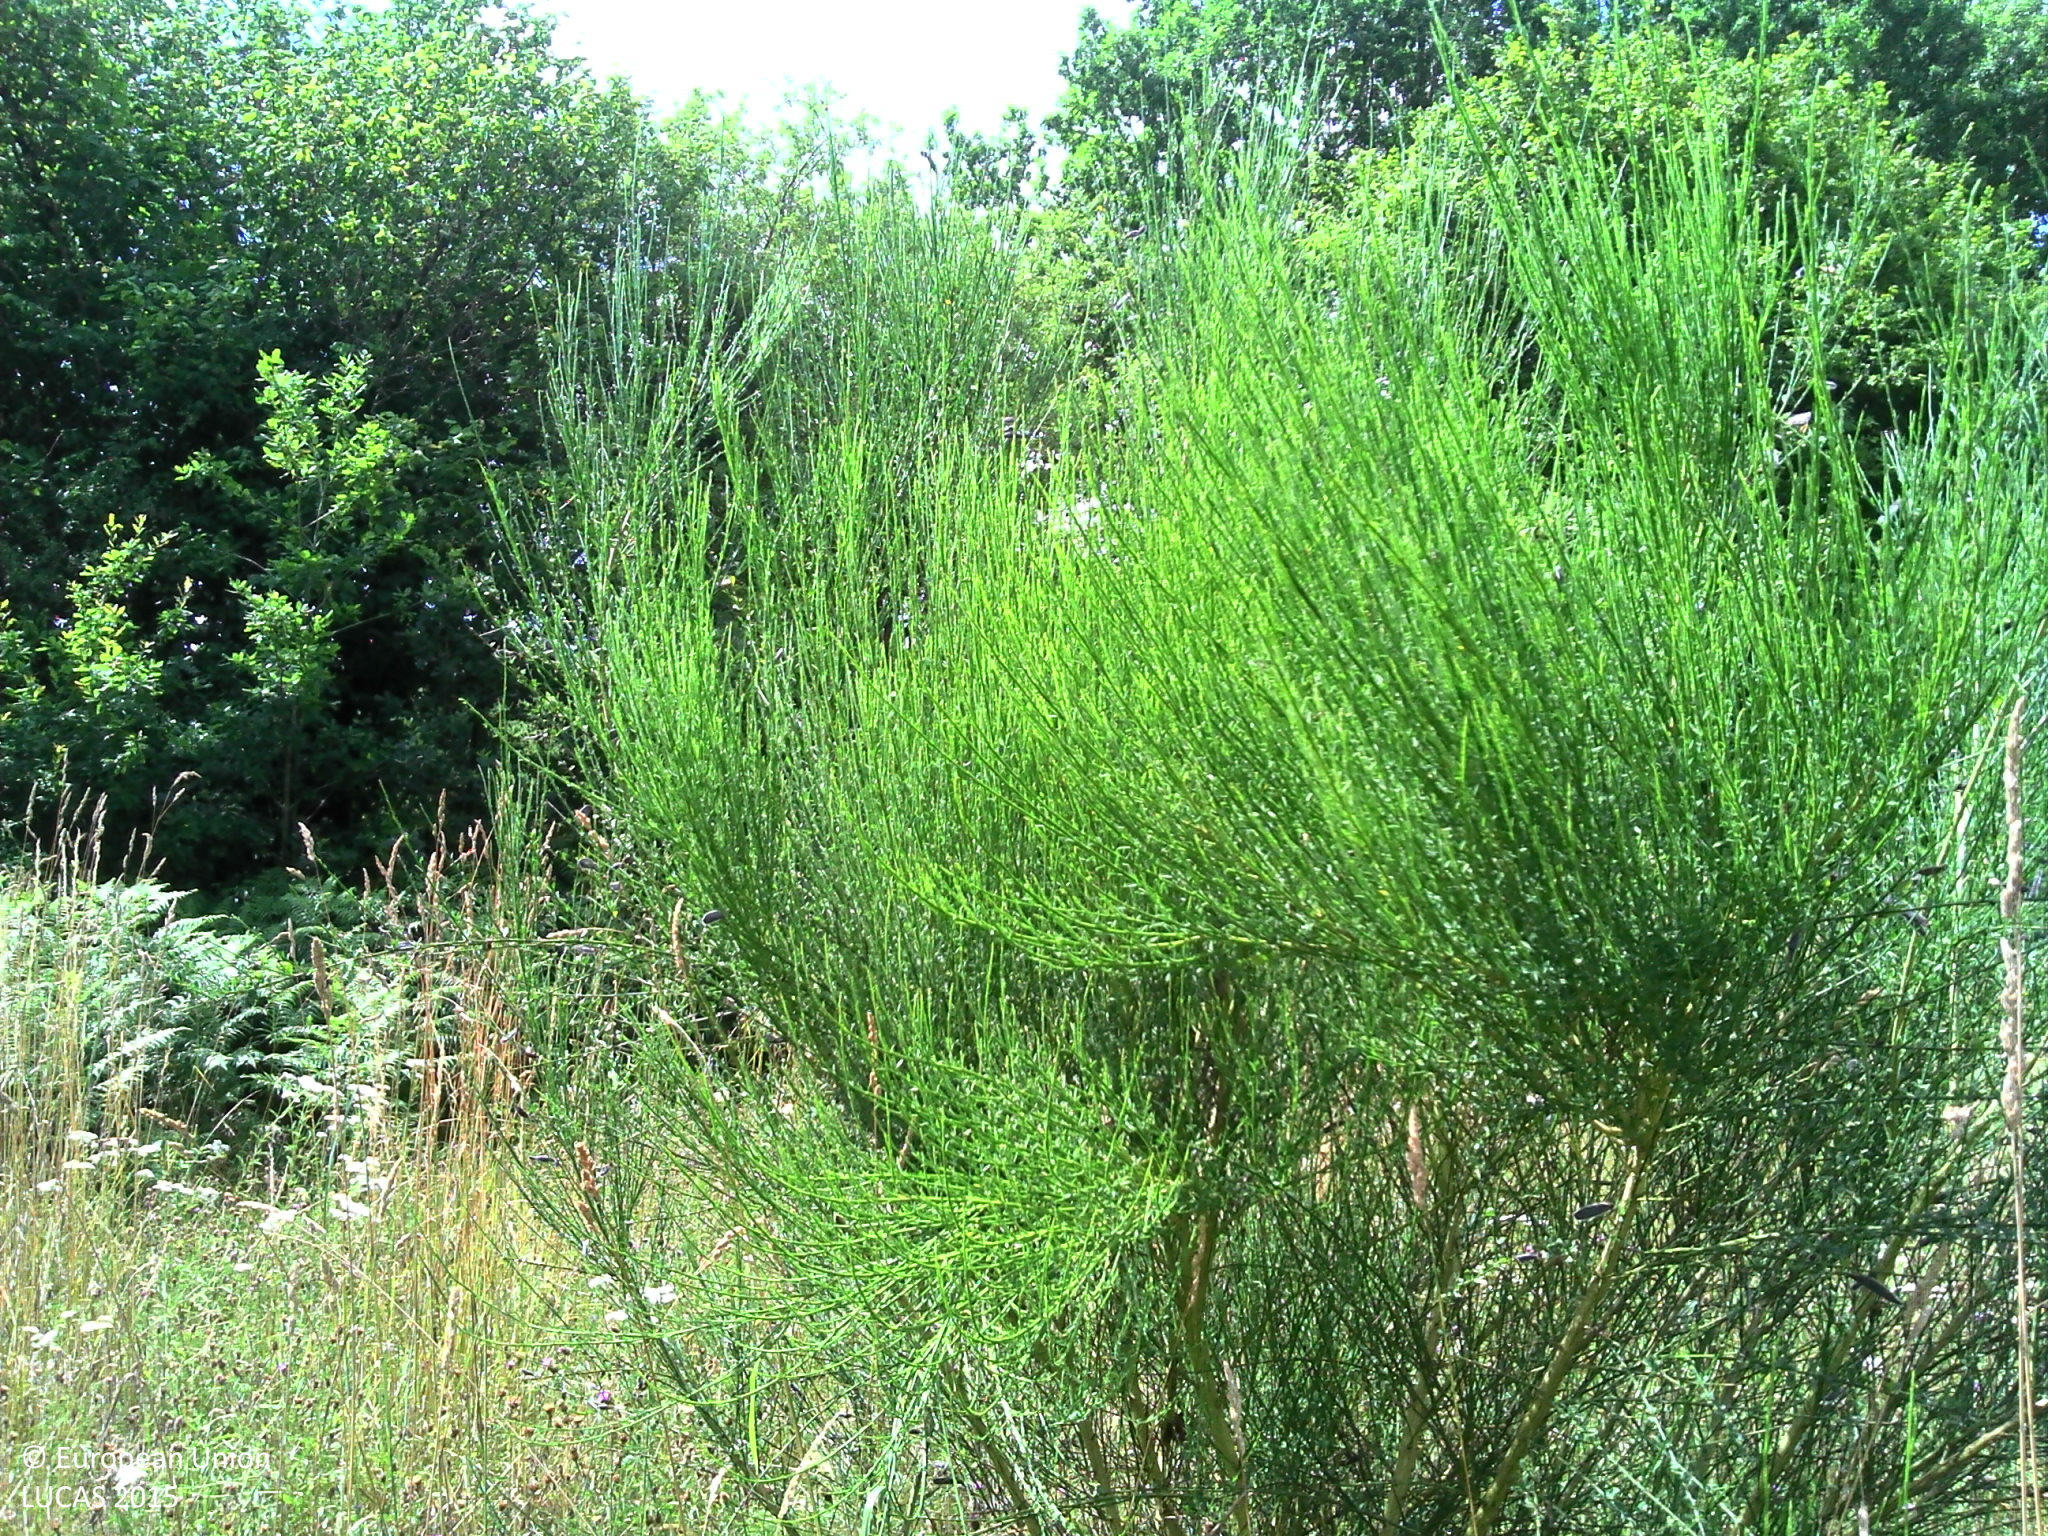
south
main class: Grassland
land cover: Spontaneously vegetated surfaces
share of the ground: > 75 %
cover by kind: herbaceous plants 95 %
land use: Agriculture (excluding fallow land and kitchen gardens)
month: July
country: FR
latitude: 45.6154
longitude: 1.0780
